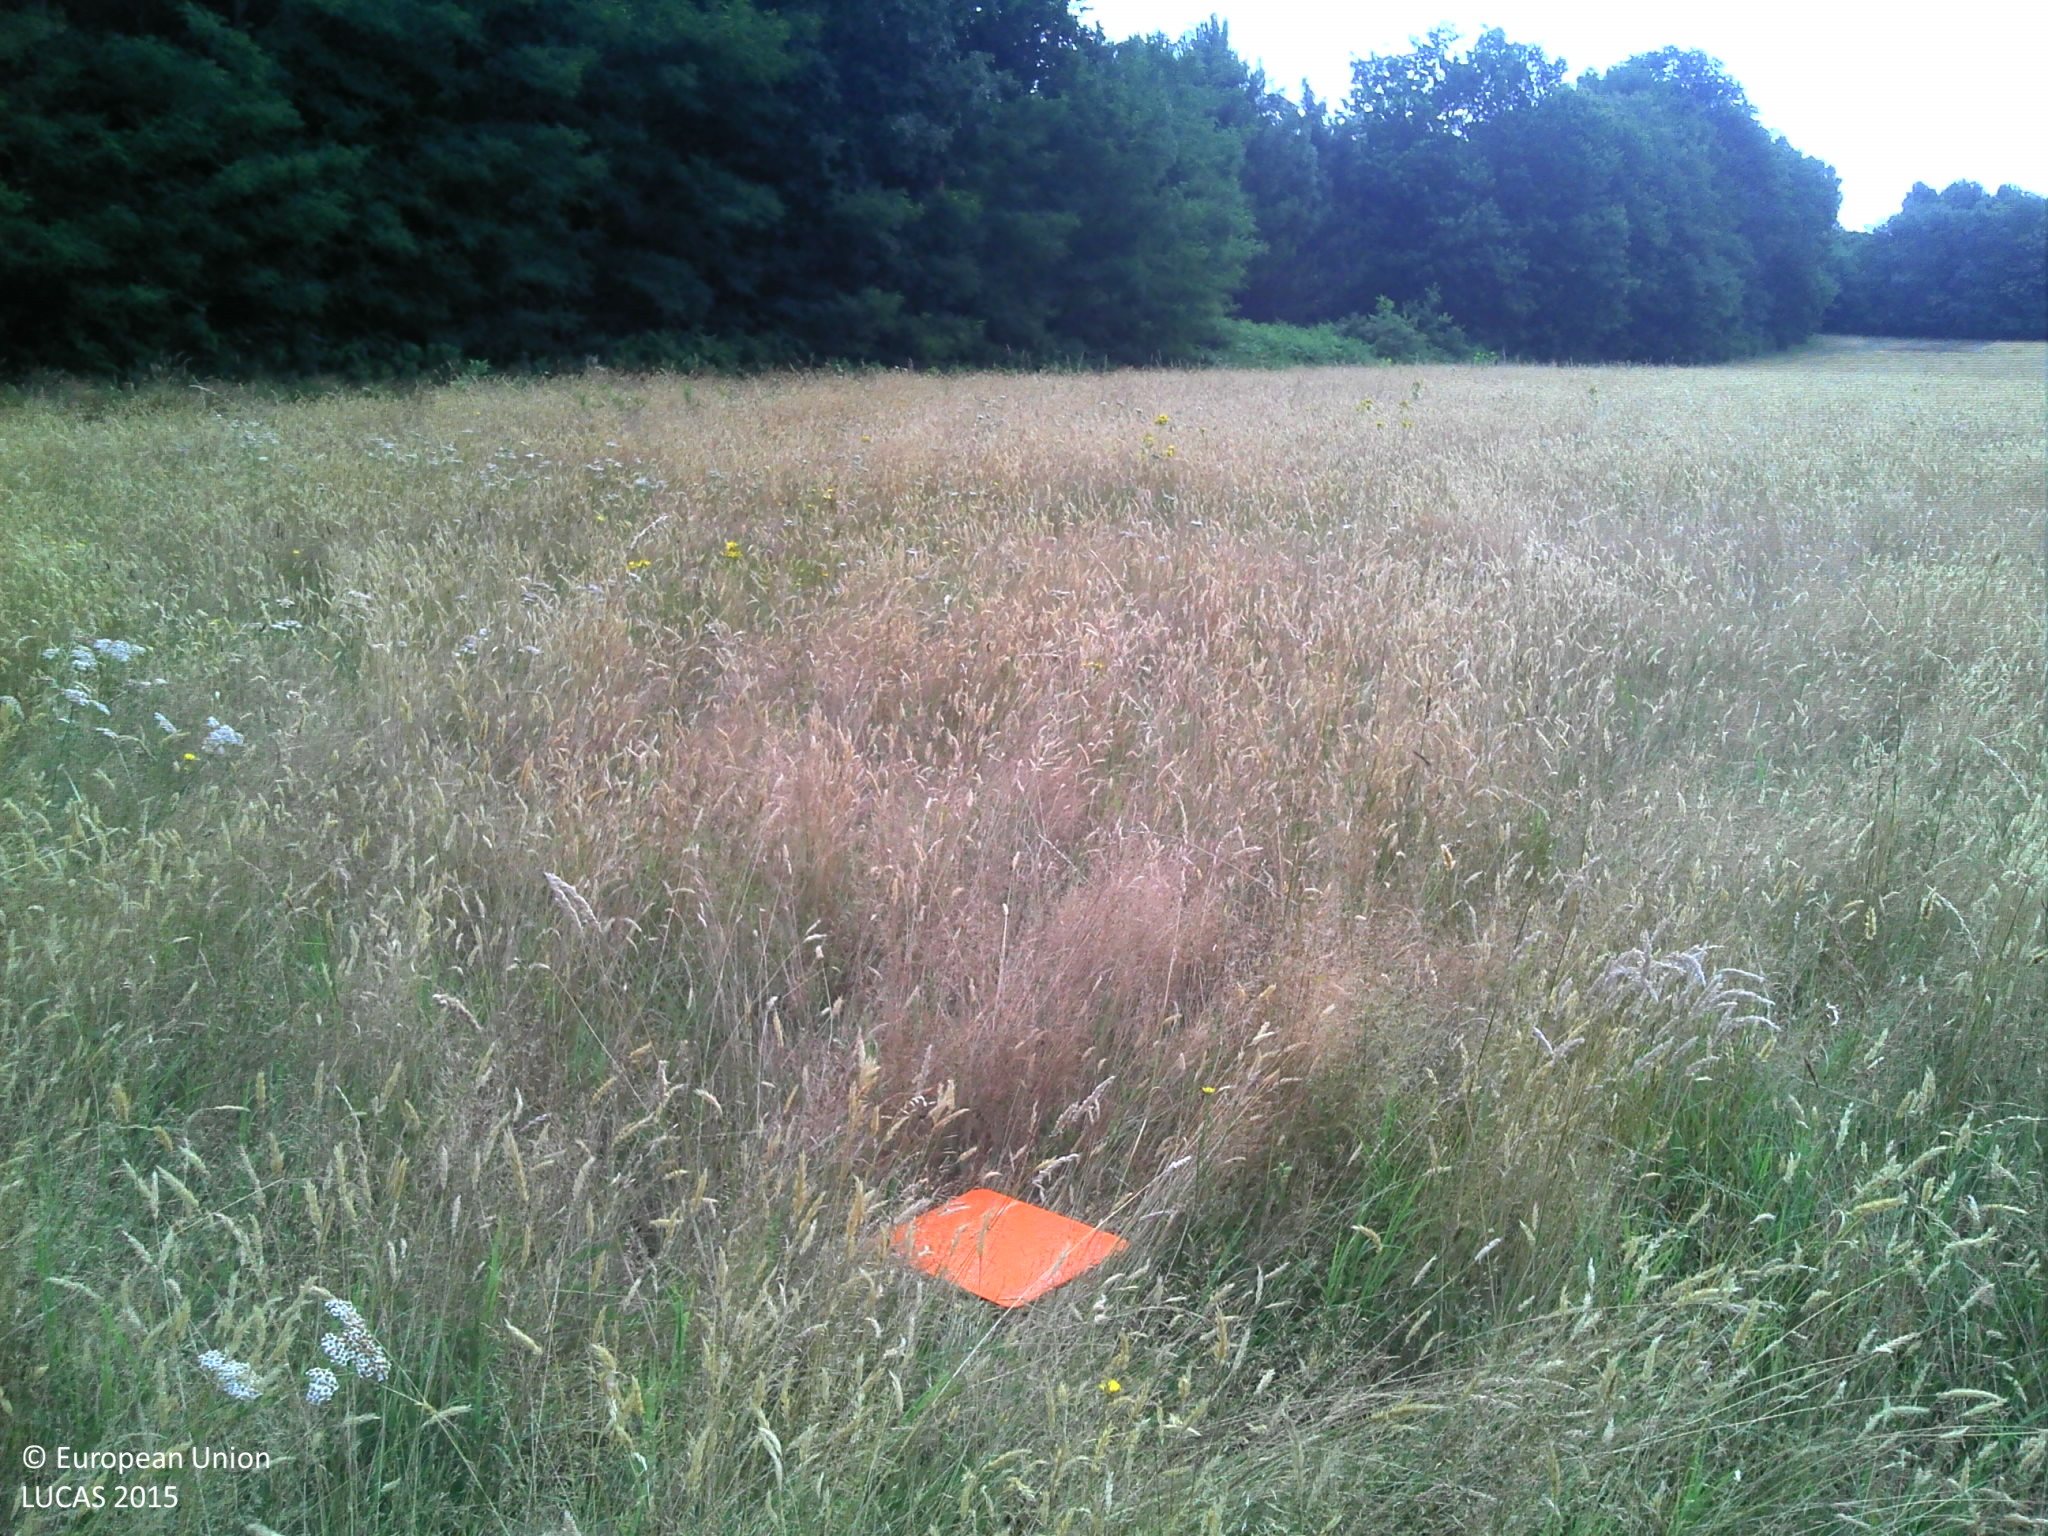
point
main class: Grassland
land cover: Grassland without tree/shrub cover
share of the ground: > 75 %
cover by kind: herbaceous plants 100 %
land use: Agriculture (excluding fallow land and kitchen gardens)
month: June
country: FR
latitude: 44.0210
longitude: -0.4541
